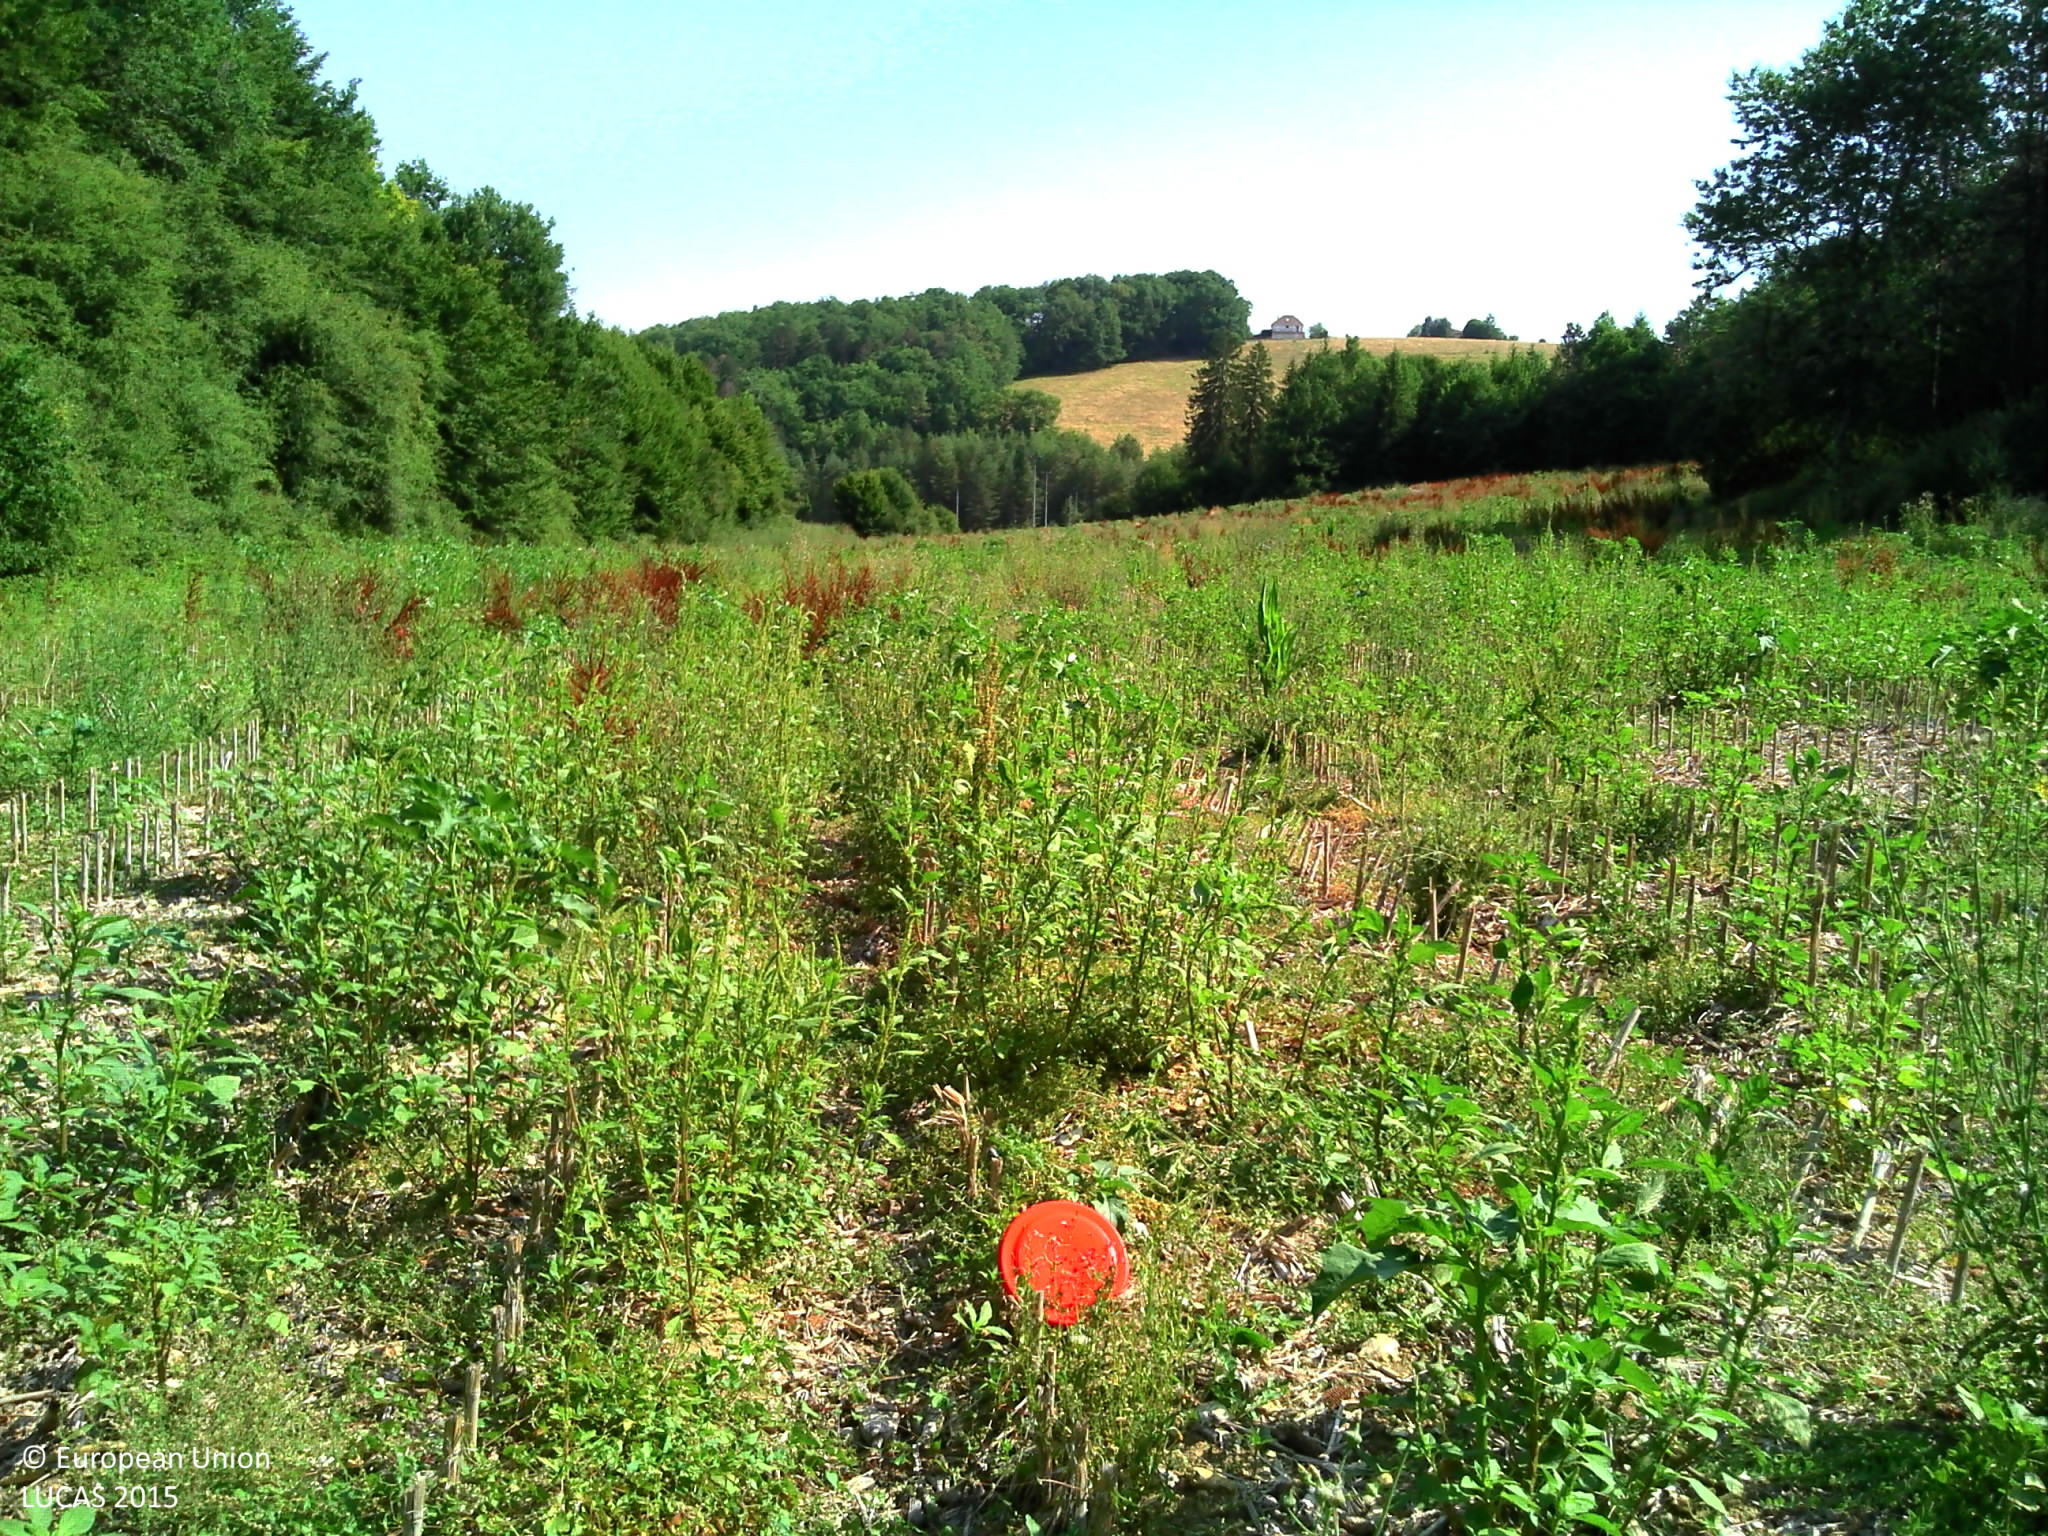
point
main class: Grassland
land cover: Spontaneously vegetated surfaces
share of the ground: 50 - 75 %
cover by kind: herbaceous plants 85 %, unconsolidated bare surface 15 %
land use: Fallow land
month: July
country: FR
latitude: 45.1134
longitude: 0.7242
